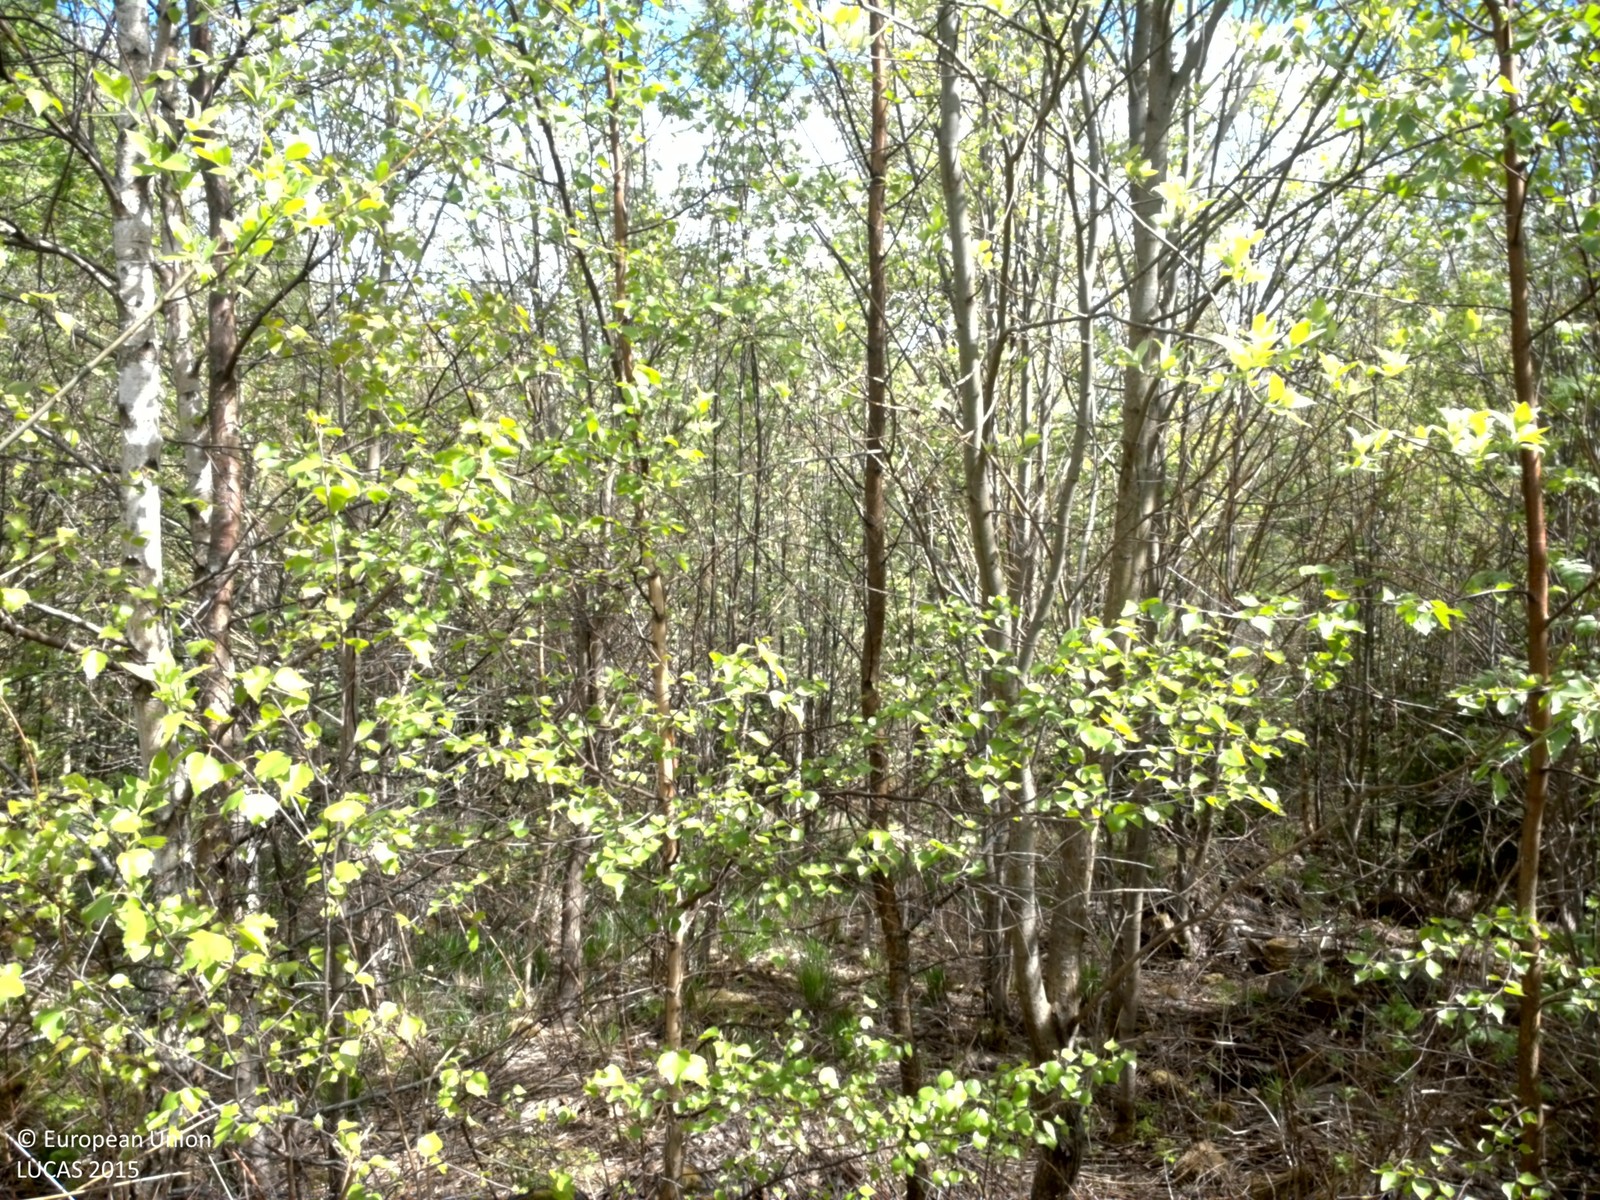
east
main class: Woodland
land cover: Broadleaved woodland
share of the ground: > 75 %
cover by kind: broadleaved forest trees 90 %, herbaceous plants 5 %, consolidated bare surface 5 %
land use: Semi-natural and natural areas not in use
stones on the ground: 10 - 25 %
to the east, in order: Broadleaved woodland; Ditches and canals; Grass margins; Paved roads, cycling and walking lanes; Grass margins; Broadleaved woodland; Rivers and streams; Broadleaved woodland; Inland marshes; Broadleaved woodland; Inland fresh water bodies
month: May
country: SE
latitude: 59.2279
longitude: 14.4251
